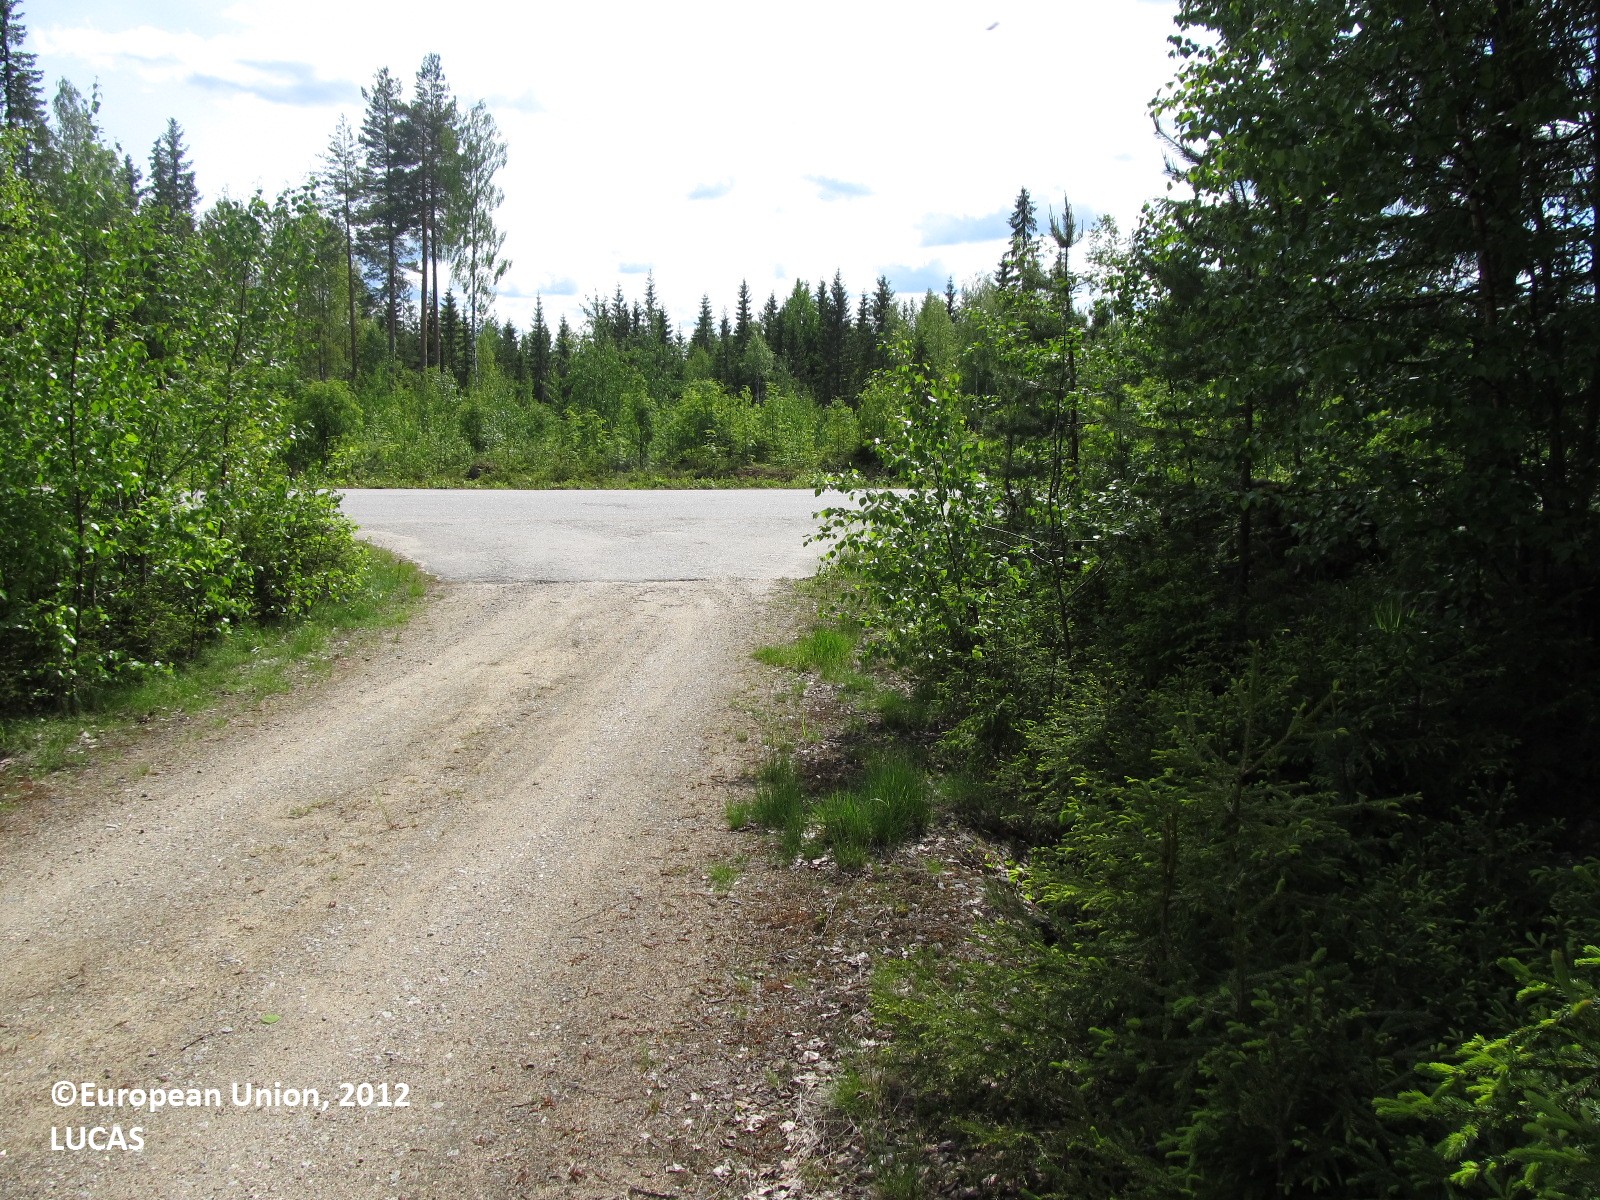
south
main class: Artificial land
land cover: Non built-up linear features
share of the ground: 25 - 50 %
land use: Road transport
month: June
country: FI
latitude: 62.5545
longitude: 28.7435
